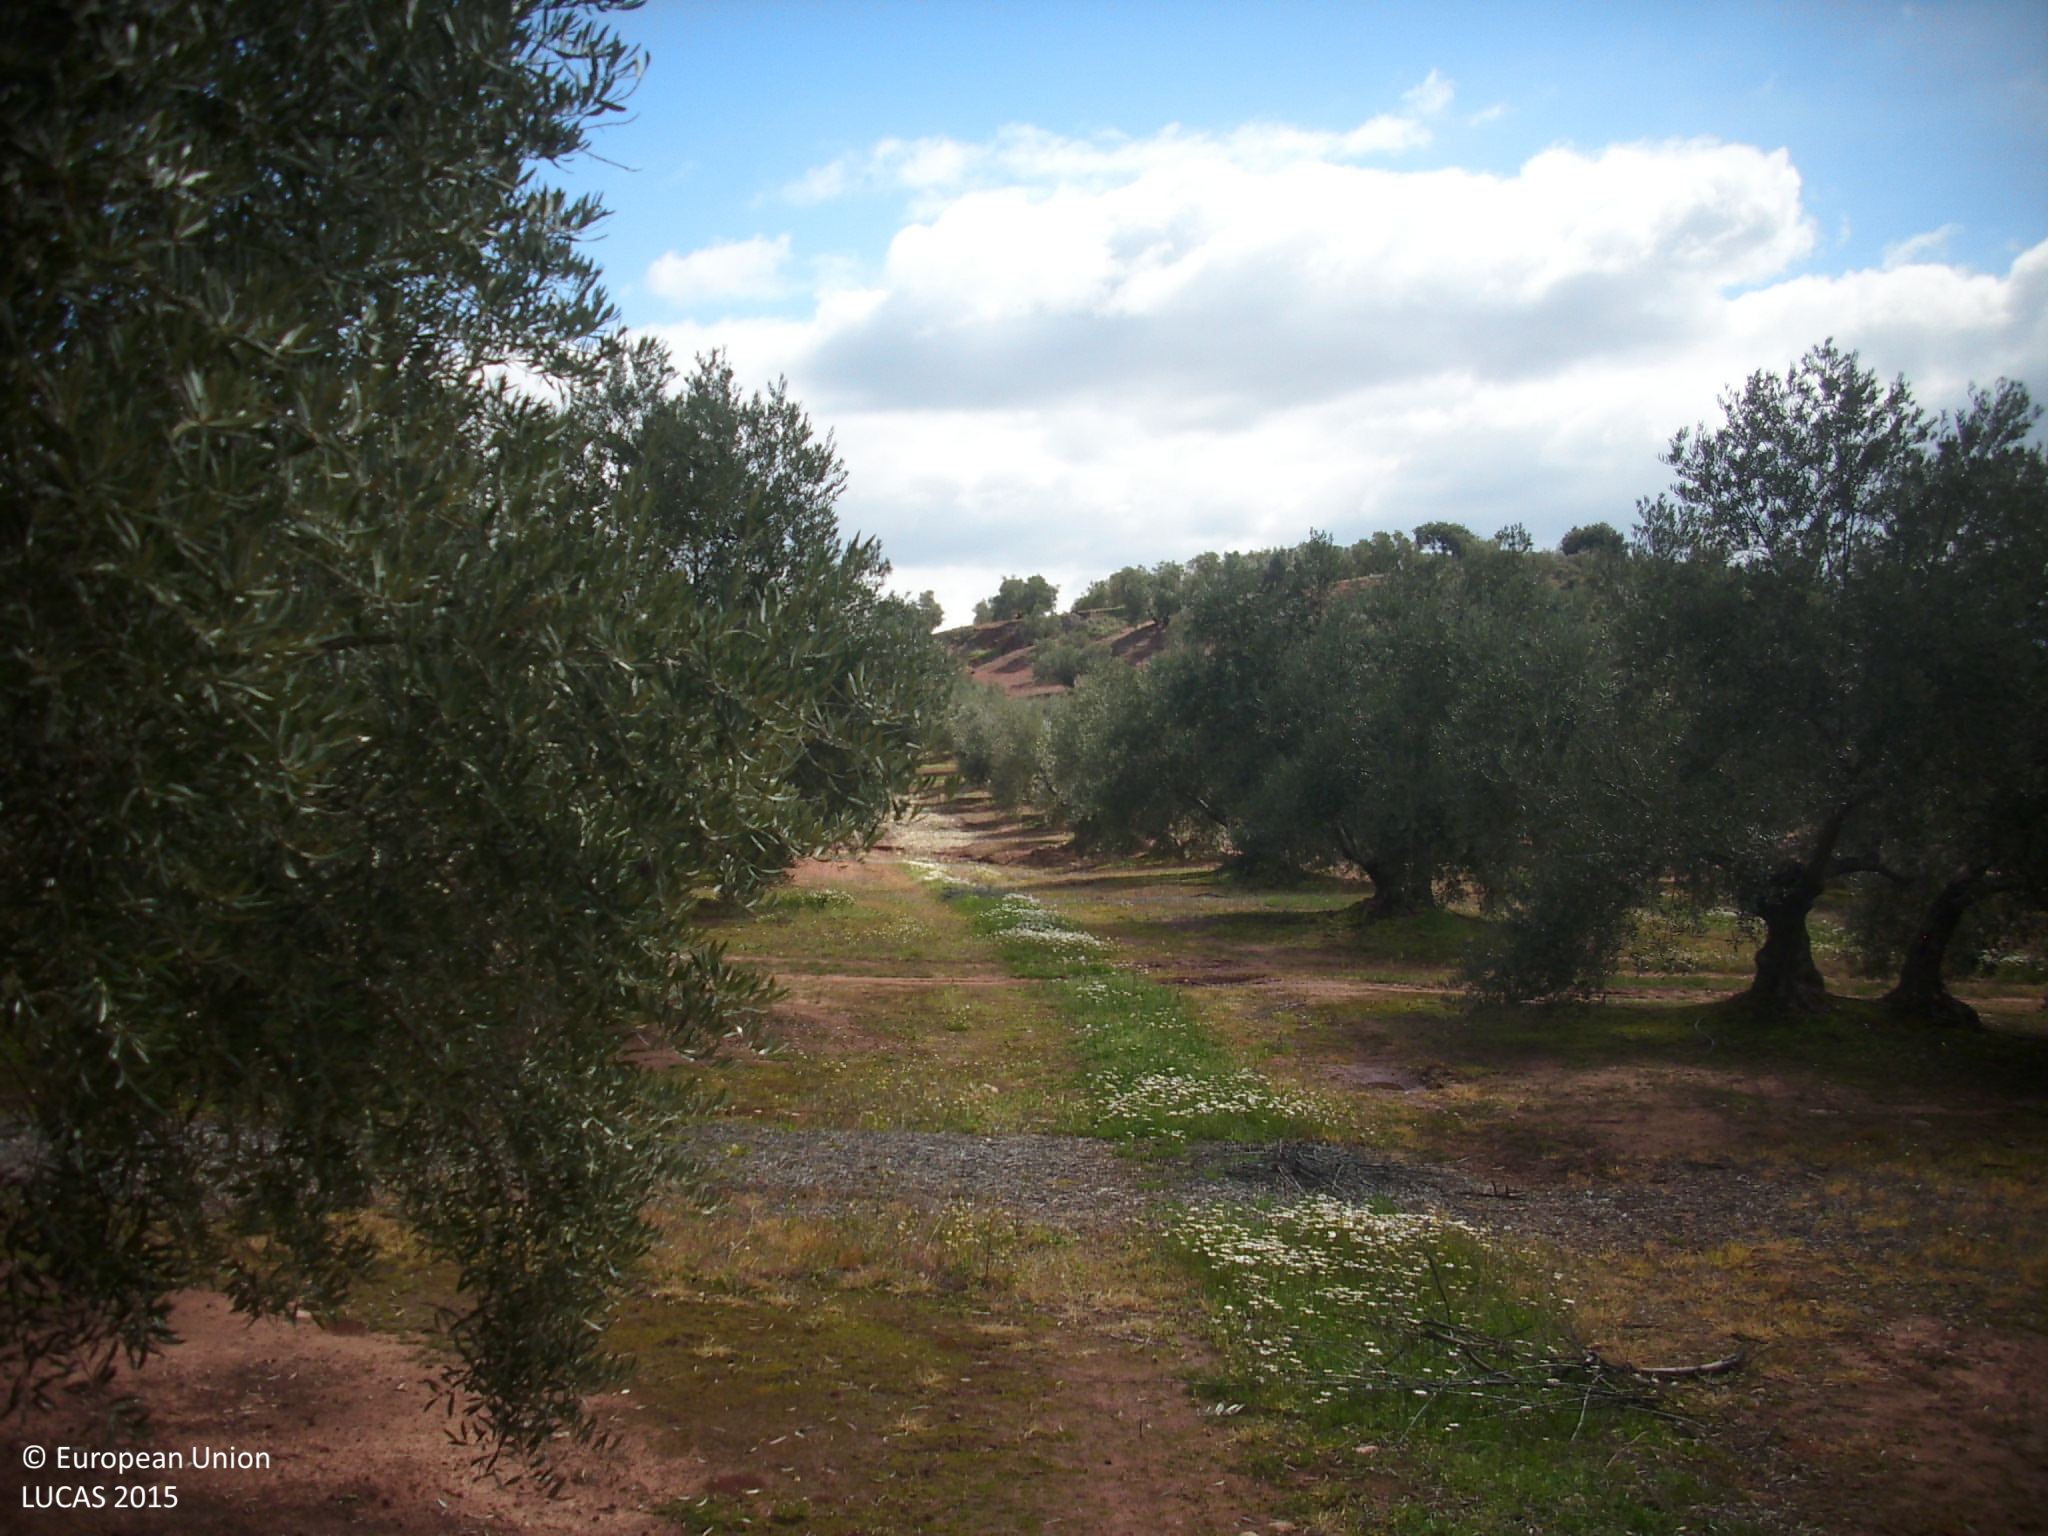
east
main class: Cropland
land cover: Olive groves
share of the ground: 25 - 50 %
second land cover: Spontaneously vegetated surfaces
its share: > 75 %
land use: Agriculture (excluding fallow land and kitchen gardens)
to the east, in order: Olive groves; Spontaneously vegetated surfaces; Olive groves; Tracks; Olive groves; Other structural elements; Grass margins; Olive groves
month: March
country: ES
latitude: 38.3343
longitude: -3.1473
